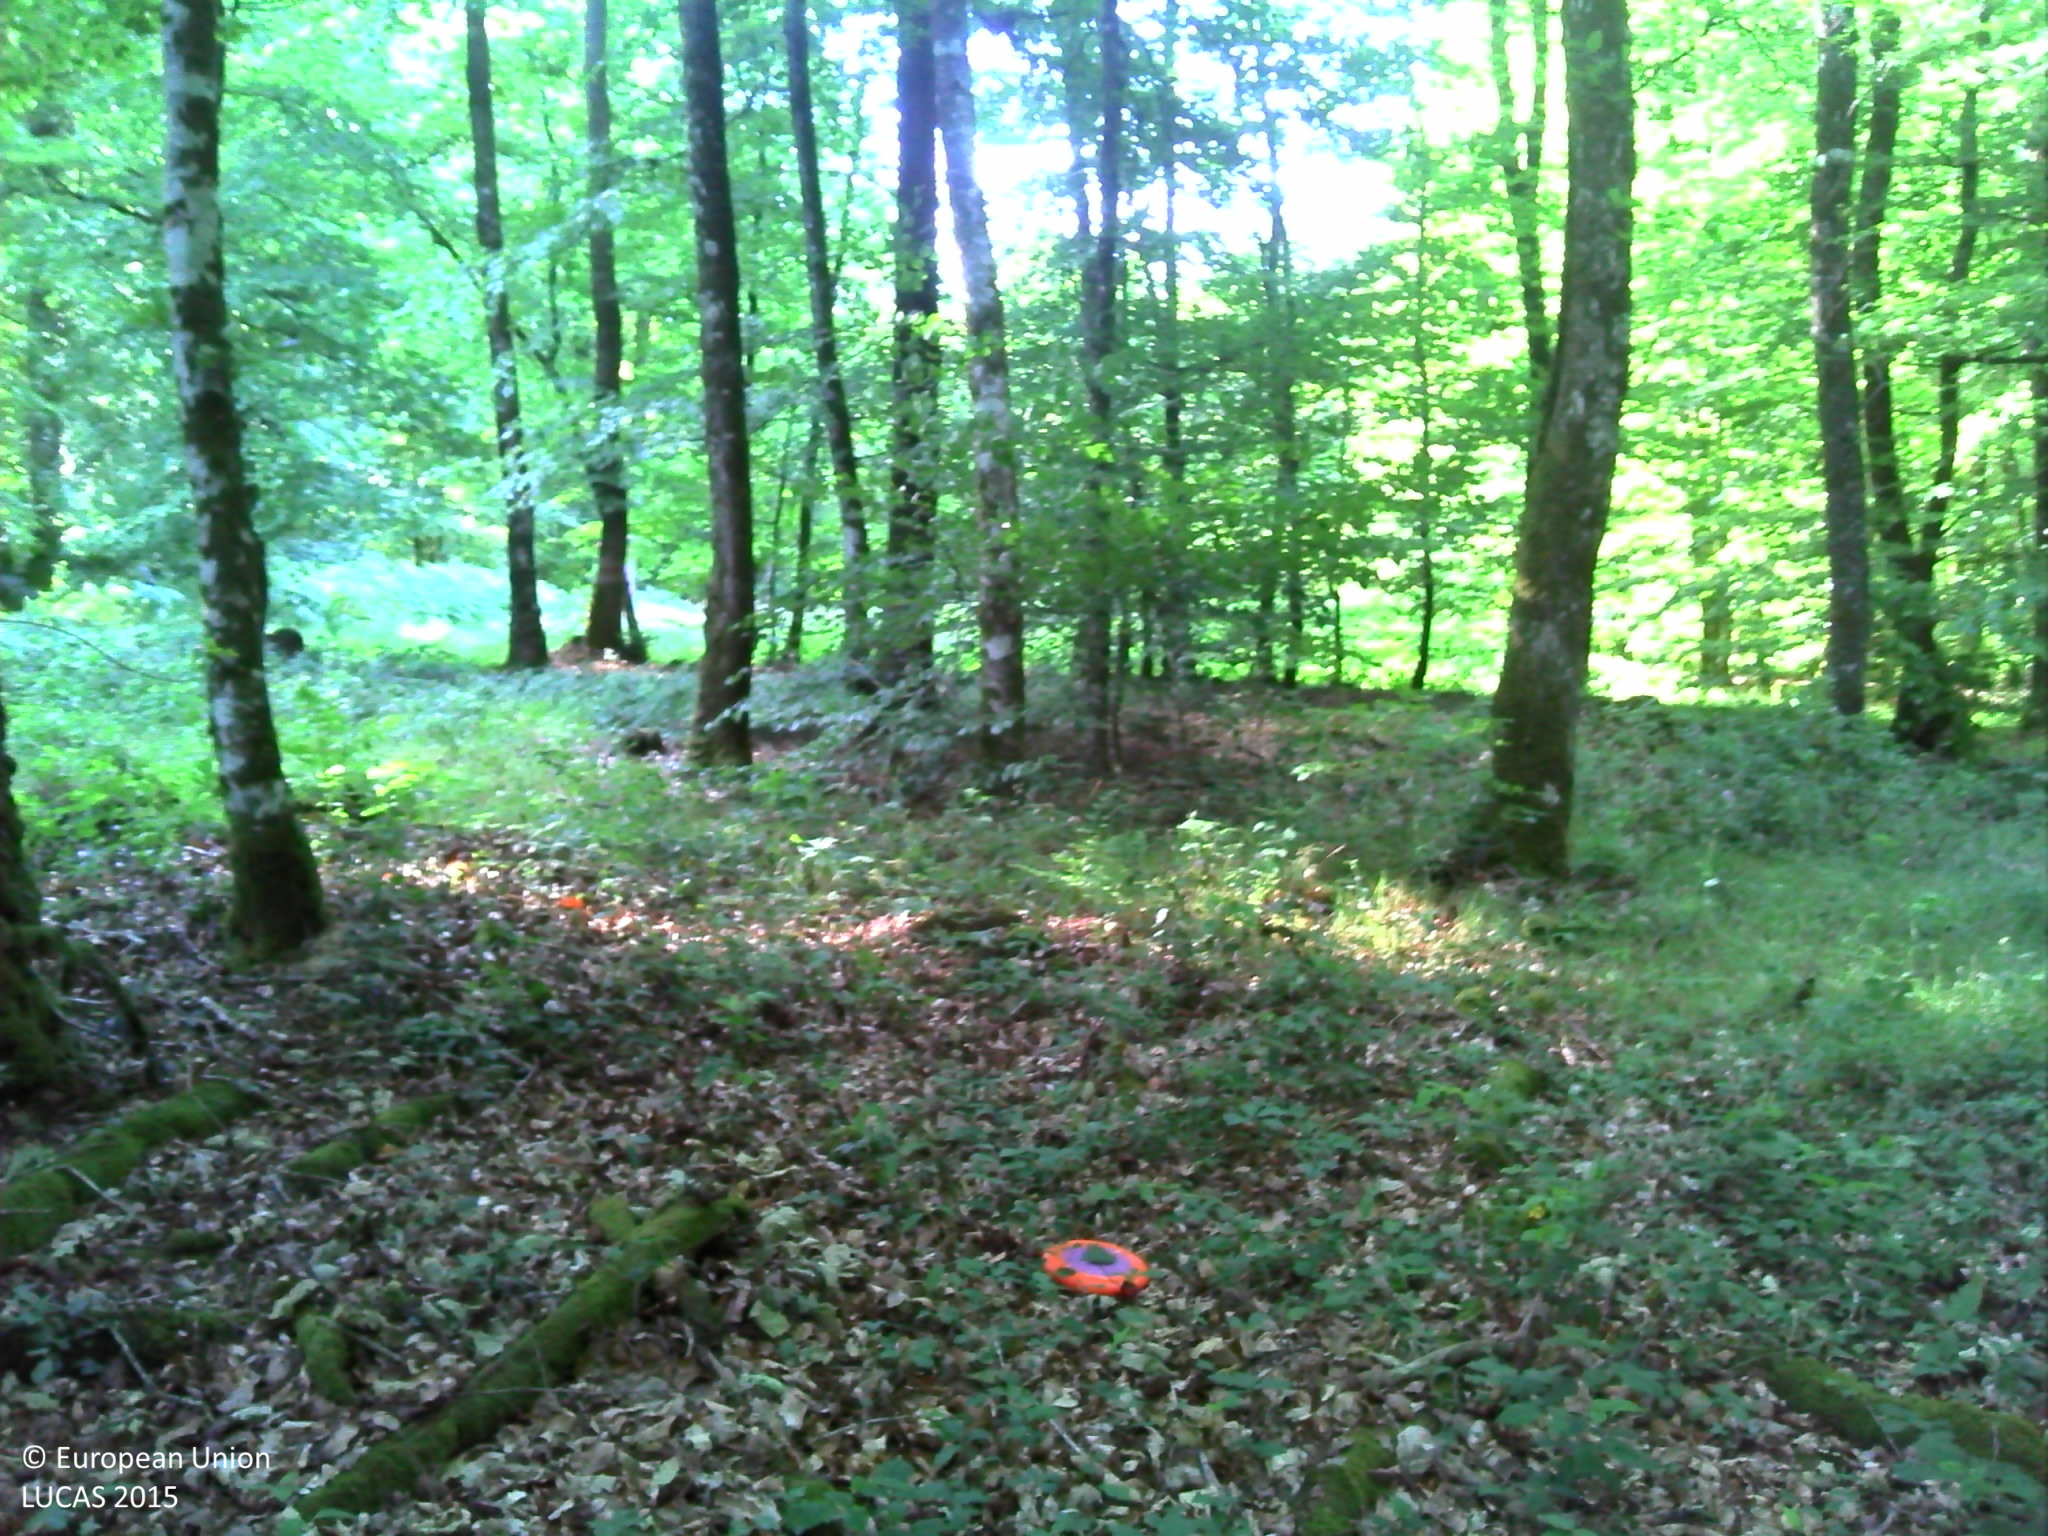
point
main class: Woodland
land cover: Broadleaved woodland
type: acidophilous oak and oak-birch forest
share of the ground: > 75 %
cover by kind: broadleaved forest trees 70 %, shrubs 15 %, herbaceous plants 15 %
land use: Forestry
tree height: > 5 m
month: June
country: FR
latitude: 48.3849
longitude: 0.2100
